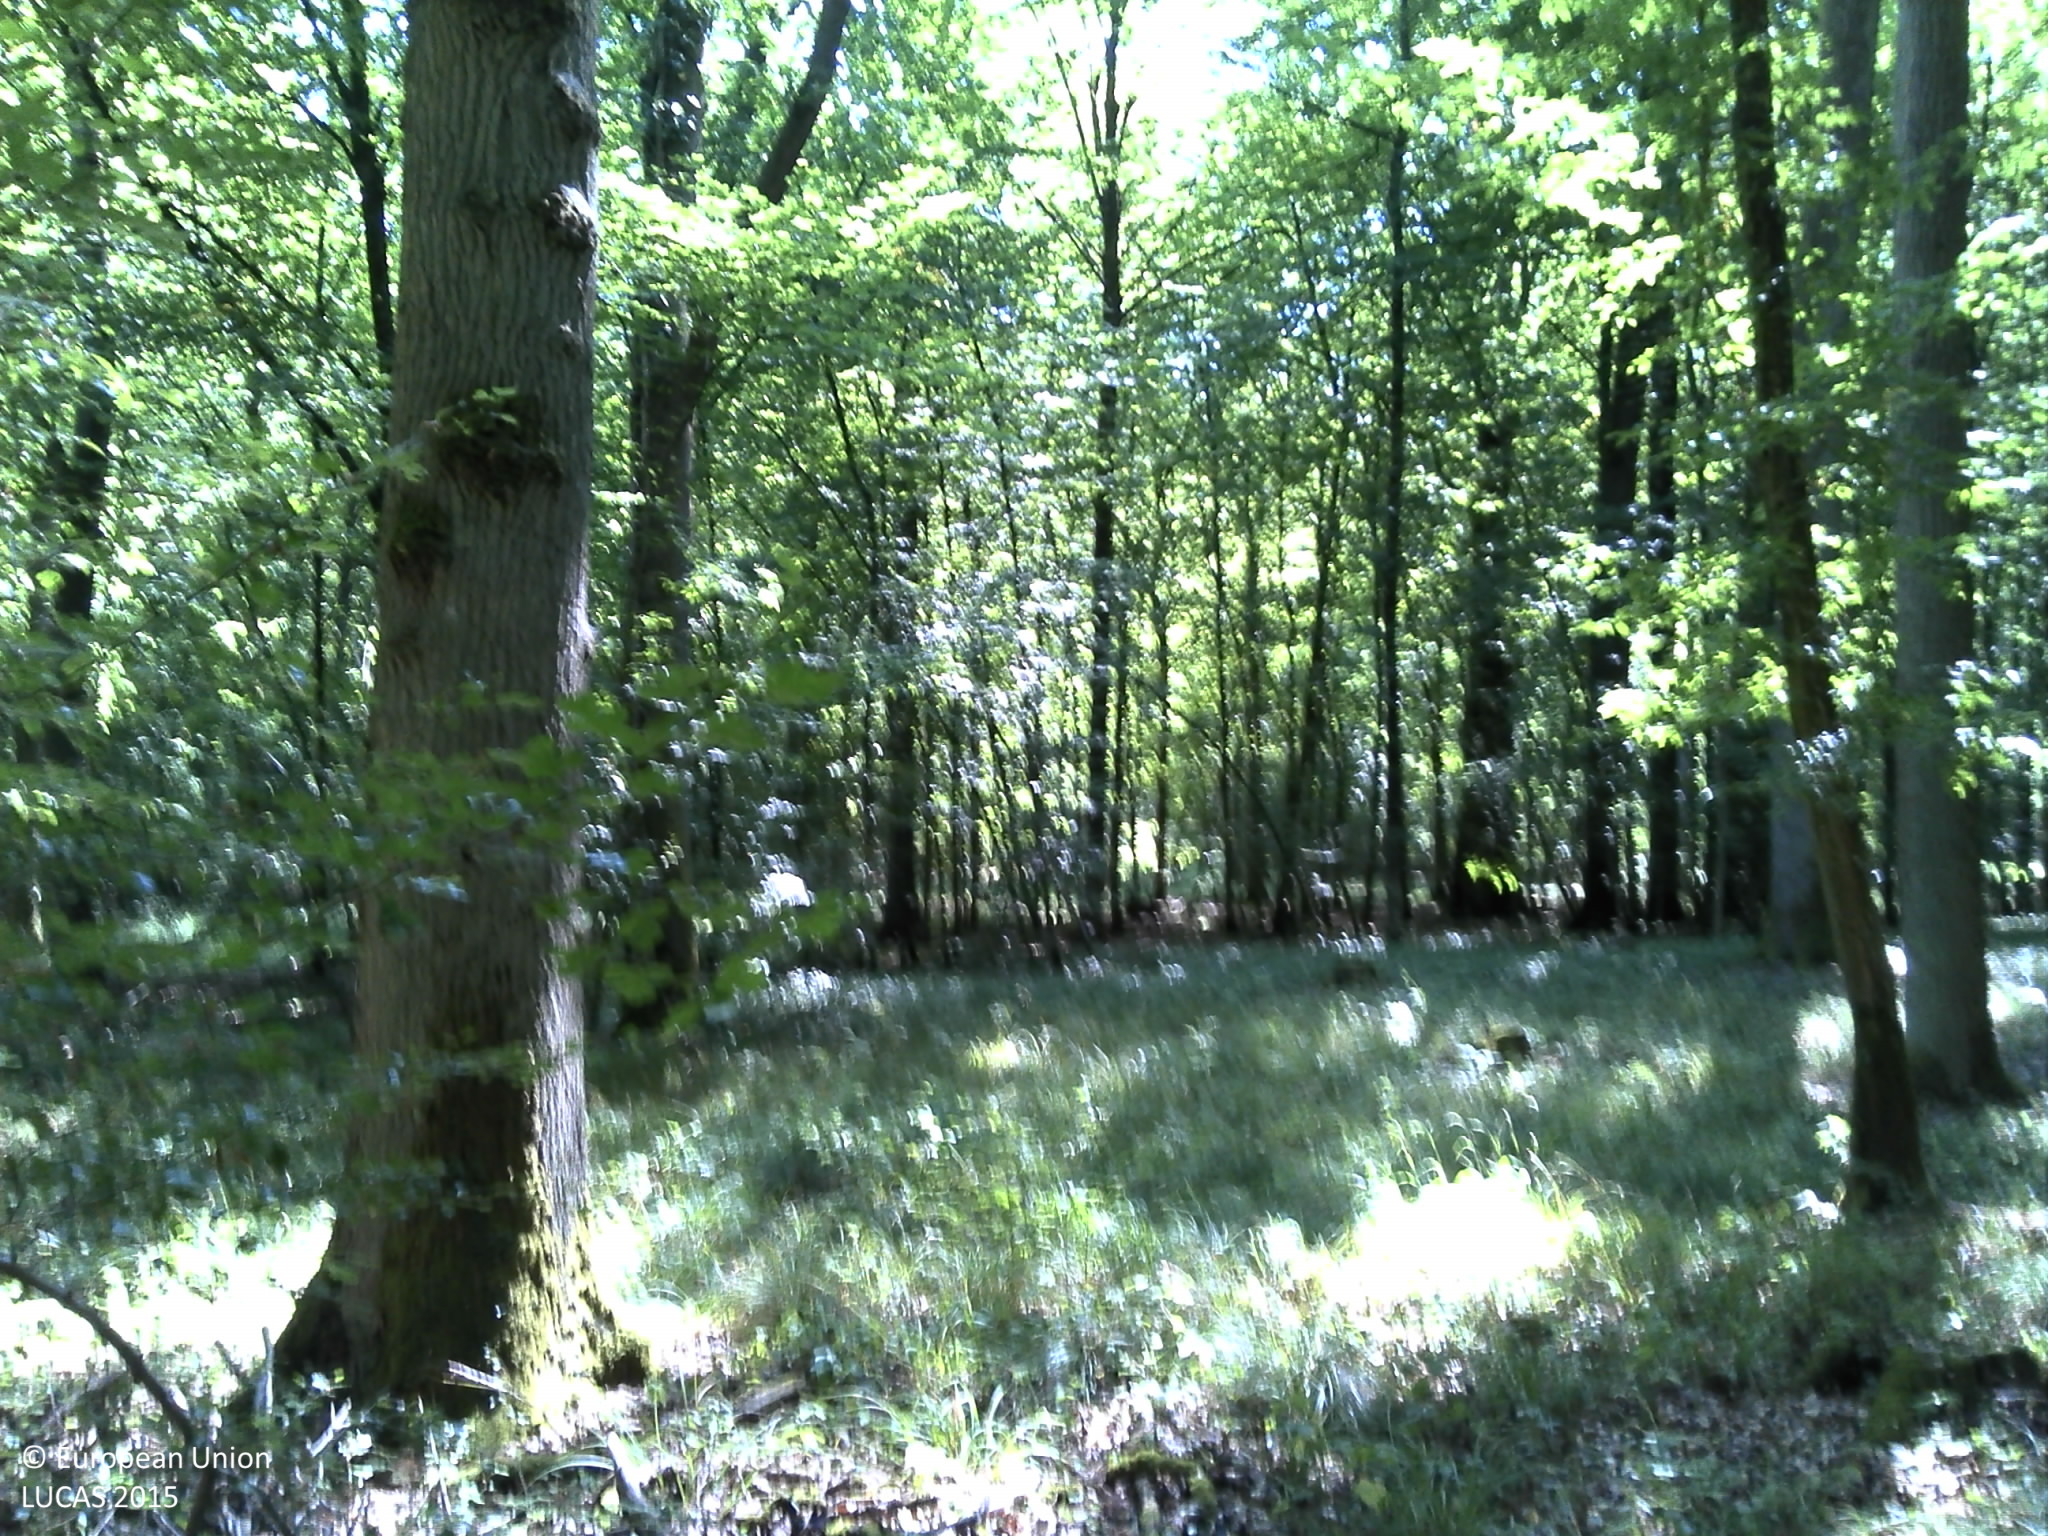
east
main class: Woodland
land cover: Broadleaved woodland
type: mesophytic deciduous forest
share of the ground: > 75 %
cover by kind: broadleaved forest trees 100 %
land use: Forestry
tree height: > 5 m
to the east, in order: Broadleaved woodland; Ditches and canals; Broadleaved woodland; Tracks; Broadleaved woodland
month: July
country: FR
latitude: 49.2124
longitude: 6.4995
